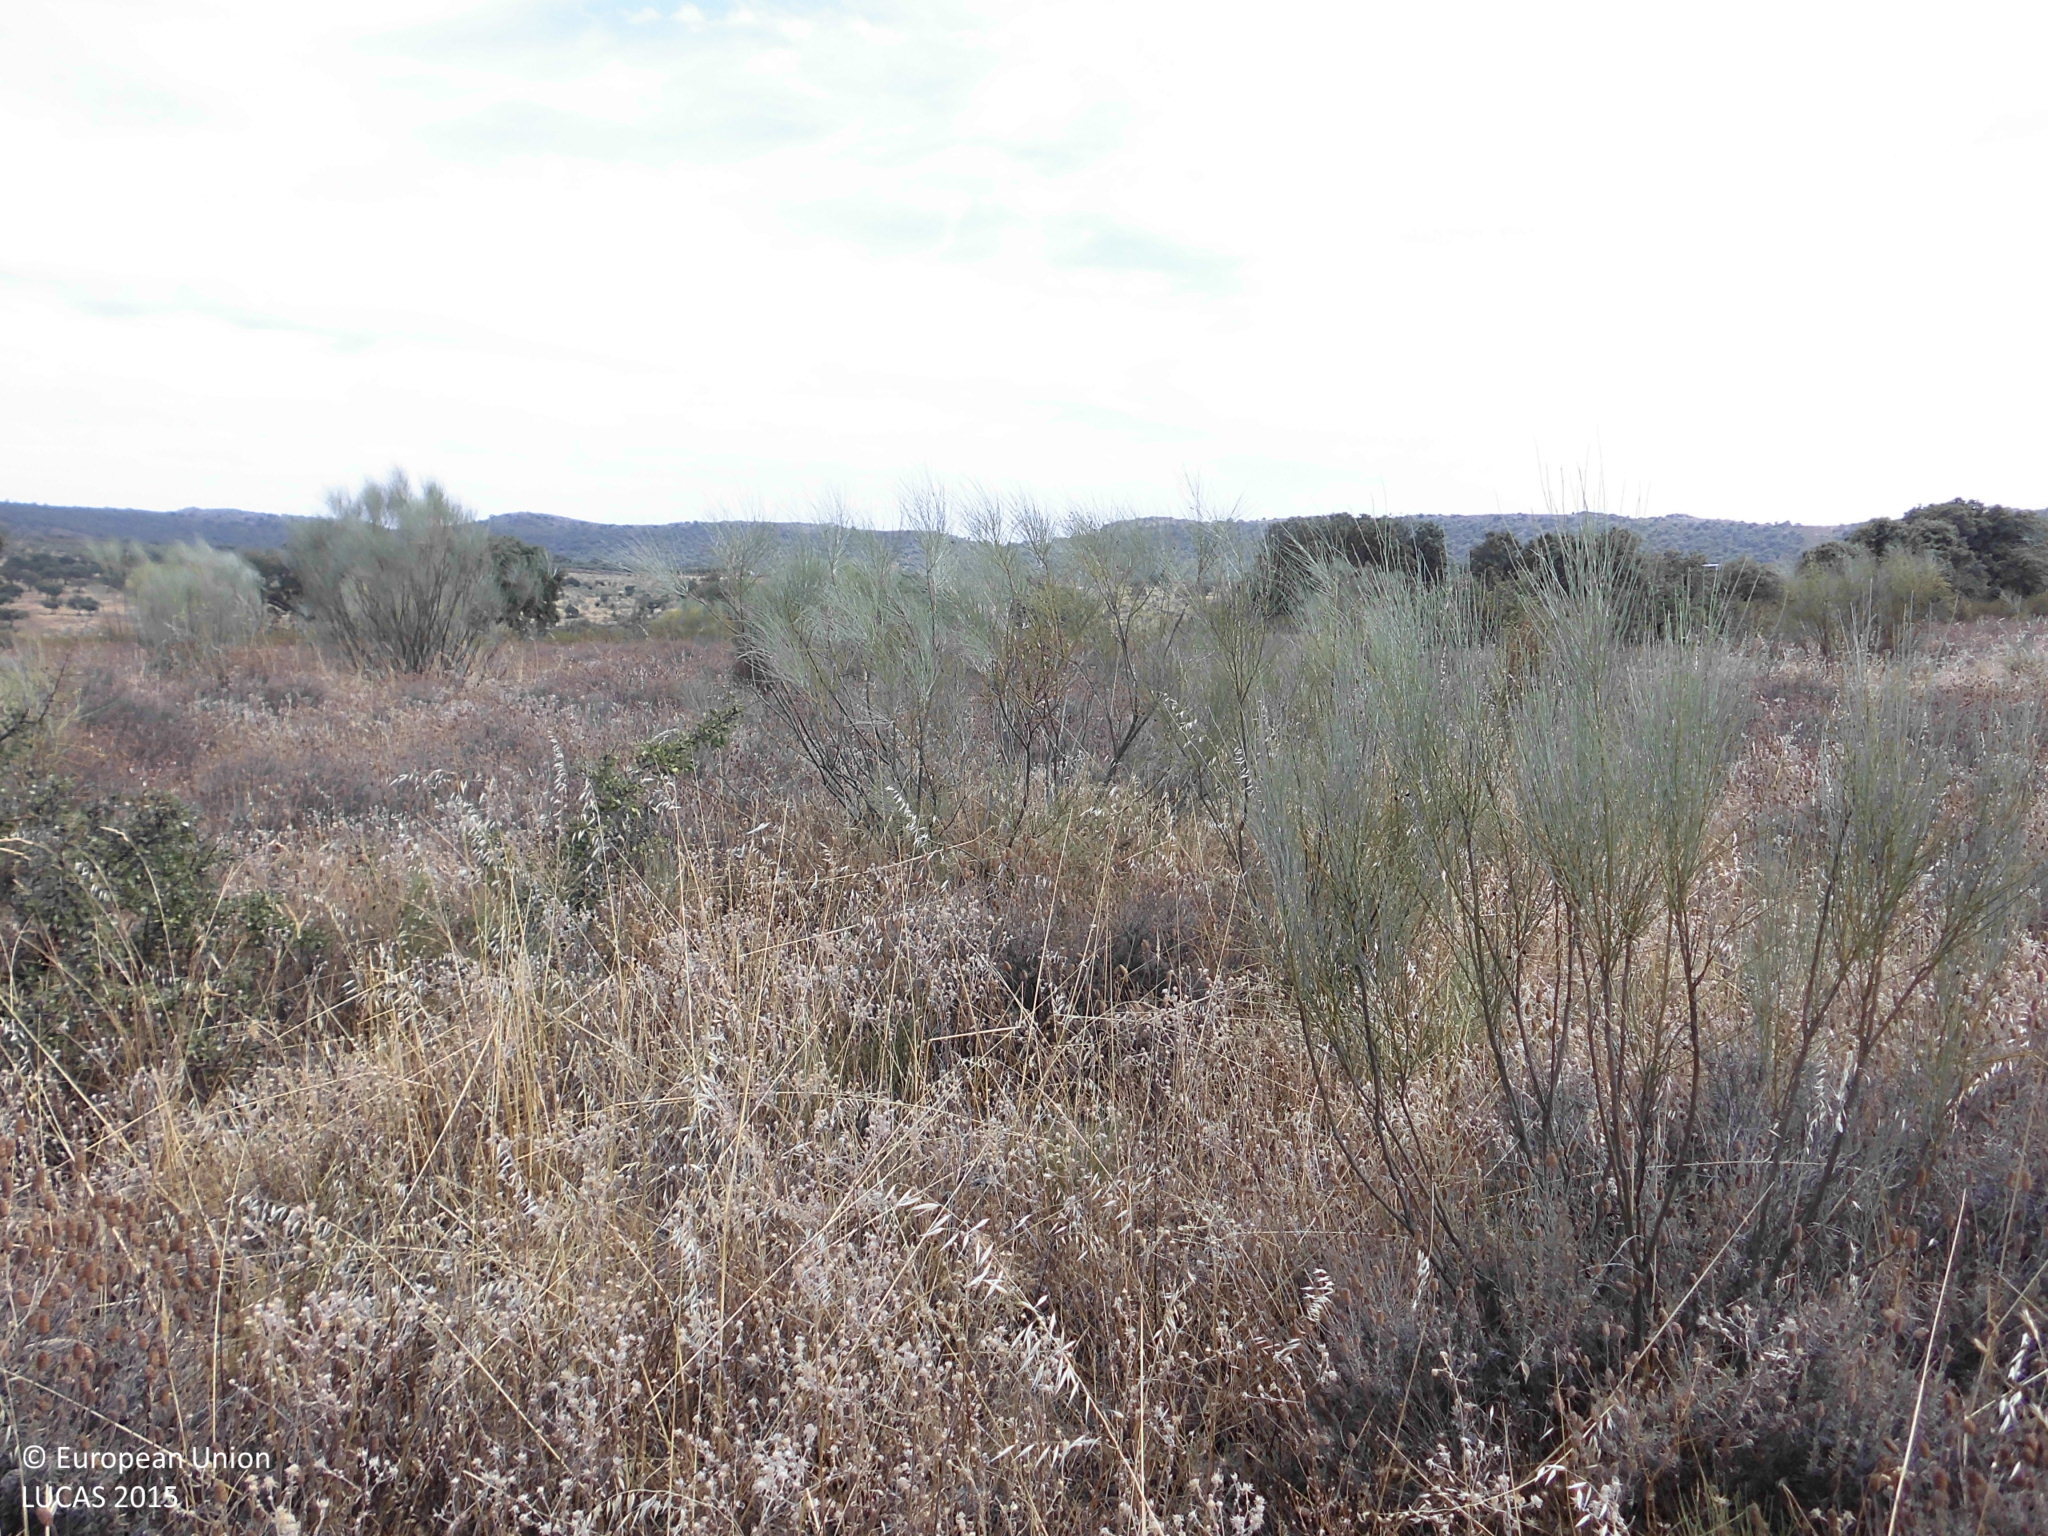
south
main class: Shrubland
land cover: Shrubland with sparse tree cover
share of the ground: 10 - 25 %
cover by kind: herbaceous plants 75 %, shrubs 20 %, broadleaved forest trees 5 %
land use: Agriculture (excluding fallow land and kitchen gardens)
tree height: > 5 m
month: July
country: ES
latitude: 39.8229
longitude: -6.4673
